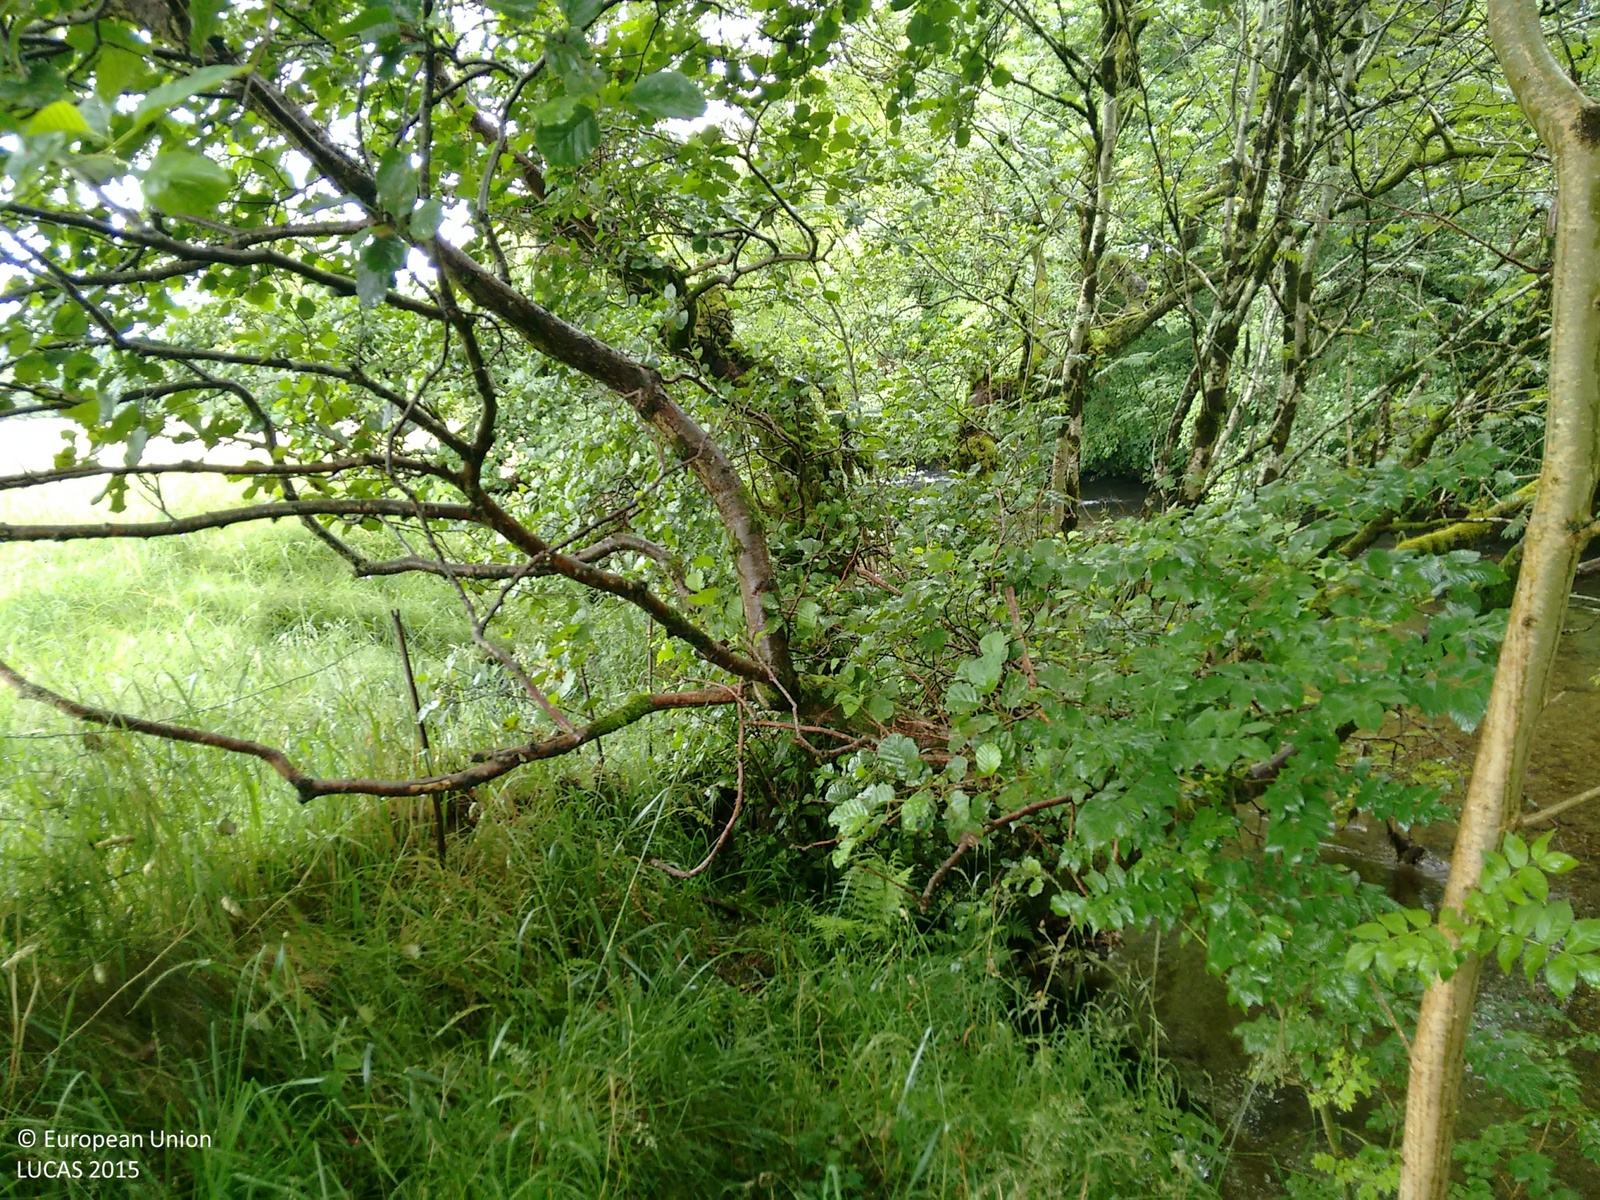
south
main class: Woodland
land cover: Broadleaved woodland
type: floodplain forest
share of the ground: > 75 %
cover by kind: broadleaved forest trees 100 %
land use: Semi-natural and natural areas not in use
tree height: > 5 m
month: August
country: GB
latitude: 55.3138
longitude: -3.4238
